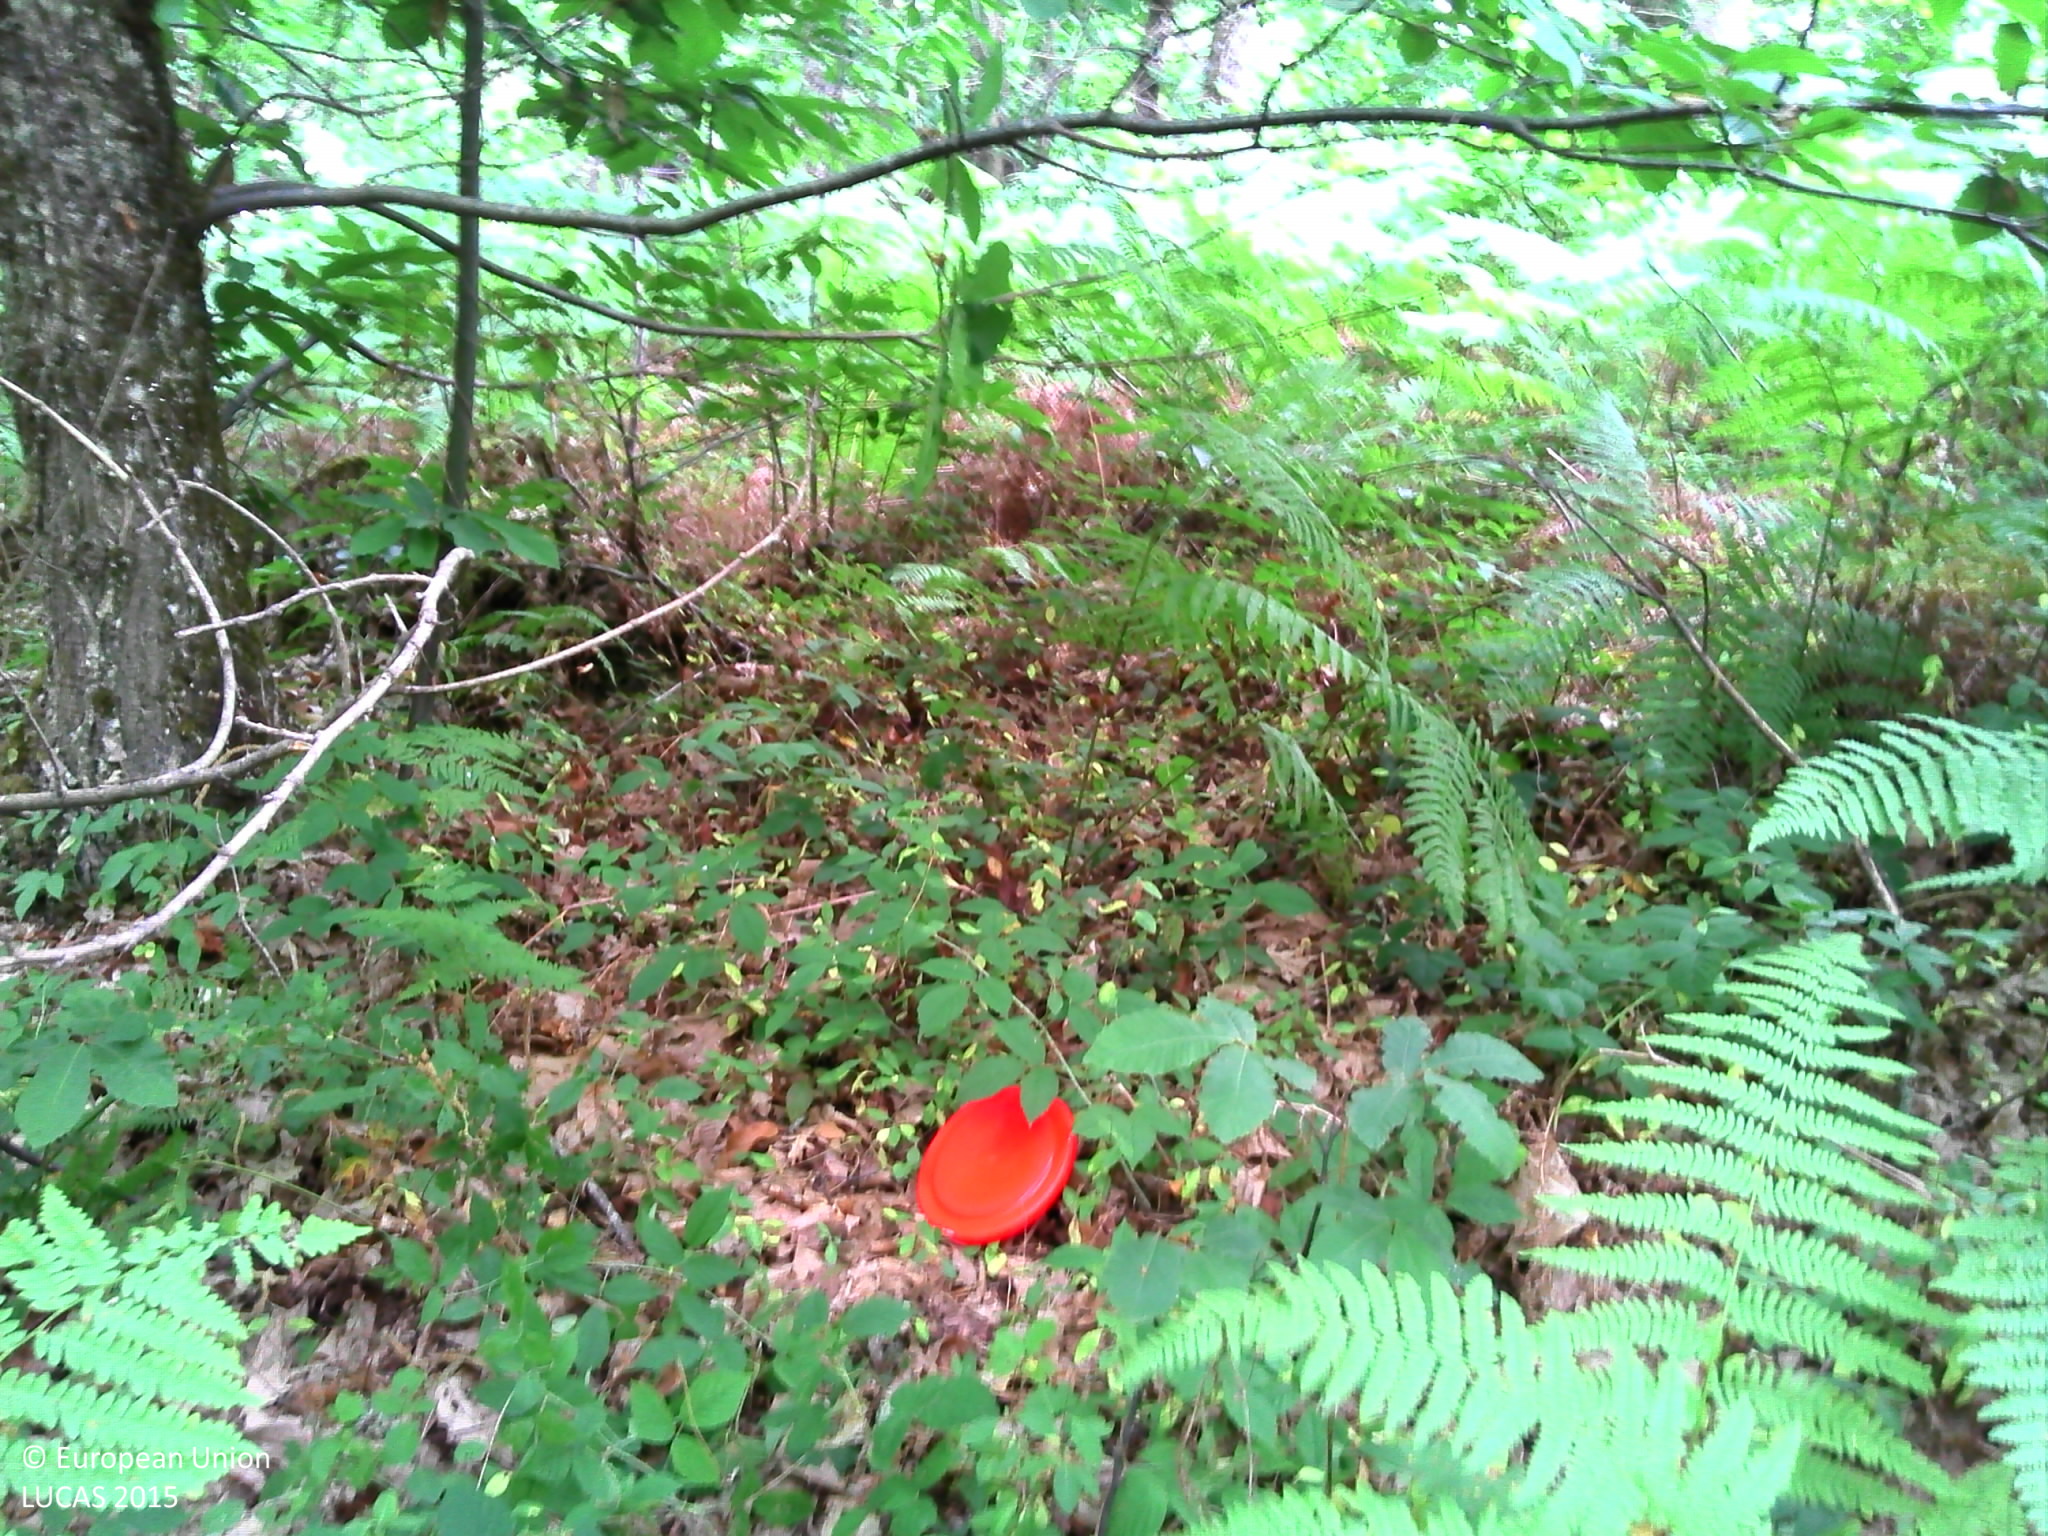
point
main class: Woodland
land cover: Broadleaved woodland
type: thermophilous deciduous forest
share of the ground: > 75 %
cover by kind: broadleaved forest trees 80 %, herbaceous plants 15 %, shrubs 5 %
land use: Forestry
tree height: > 5 m
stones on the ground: 10 - 25 %
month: July
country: FR
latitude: 45.0978
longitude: 0.7525
